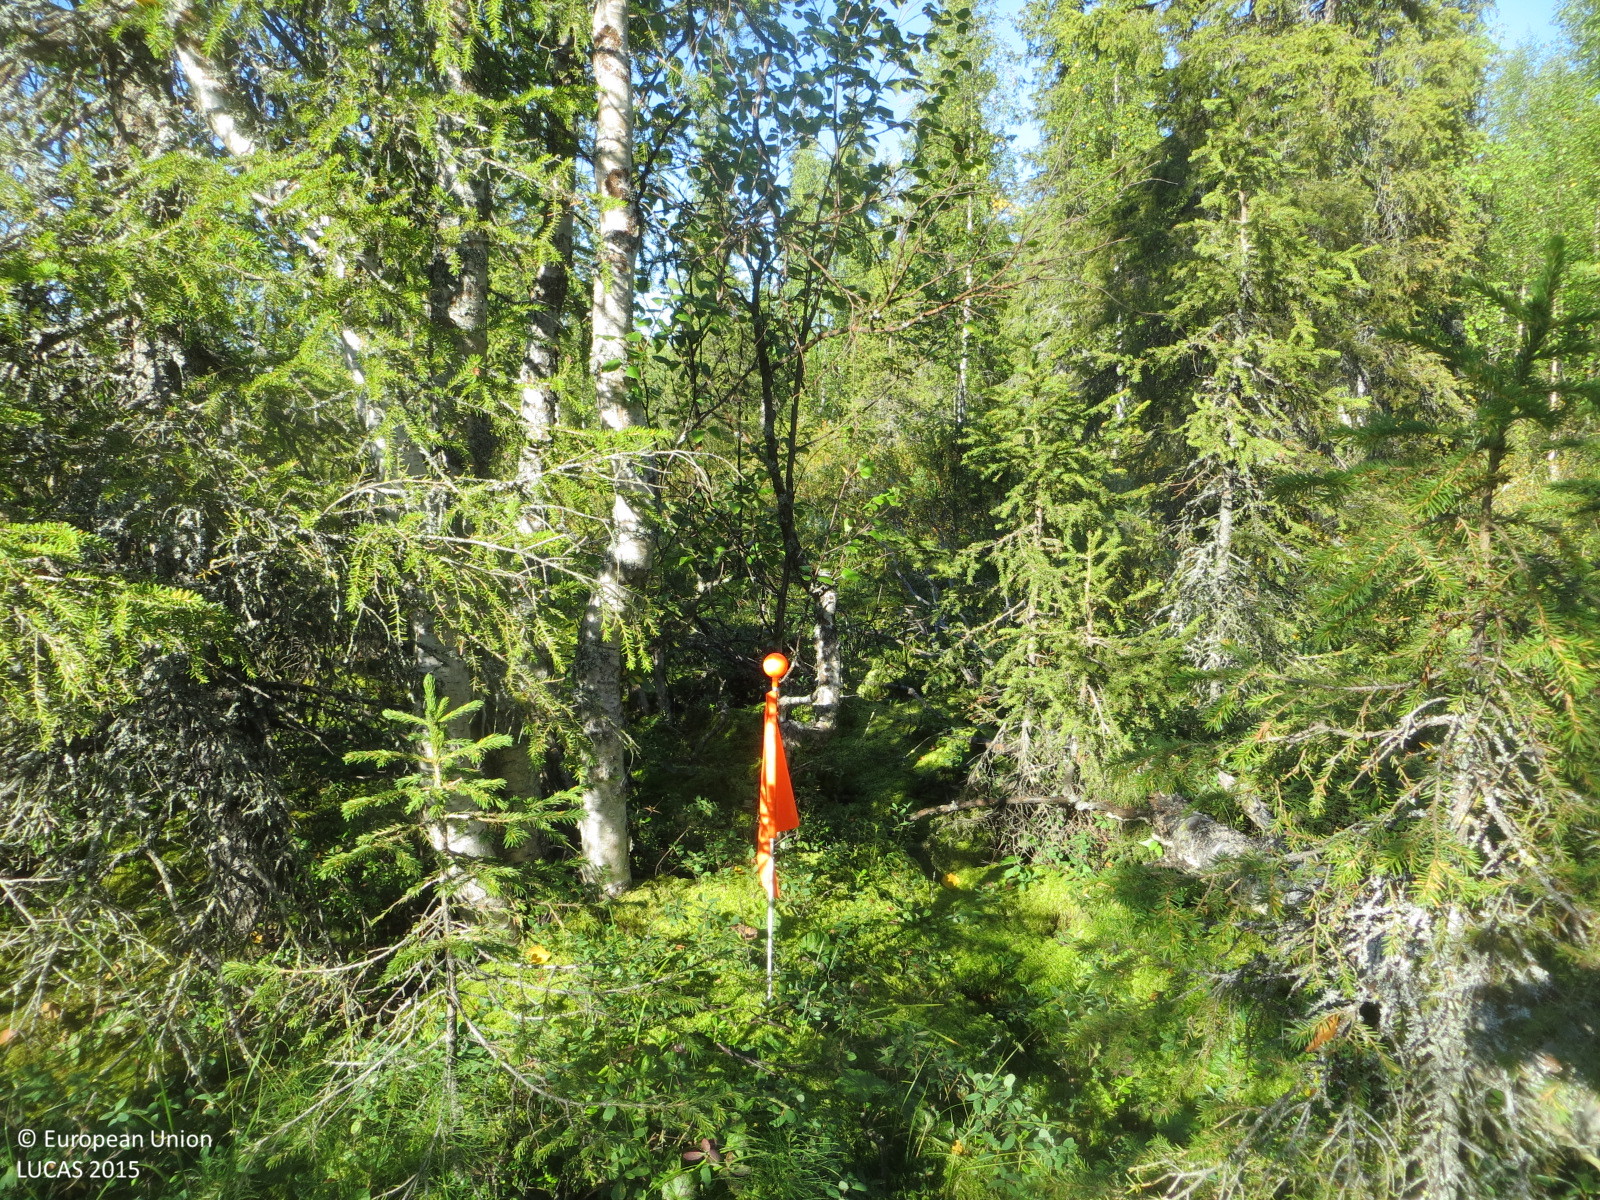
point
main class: Woodland
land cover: Spruce dominated mixed woodland
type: mire and swamp forests
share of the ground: 50 - 75 %
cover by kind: broadleaved forest trees 35 %, shrubs 35 %, coniferous forest trees 30 %
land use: Forestry
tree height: > 5 m
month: August
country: FI
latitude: 67.6148
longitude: 24.1654
